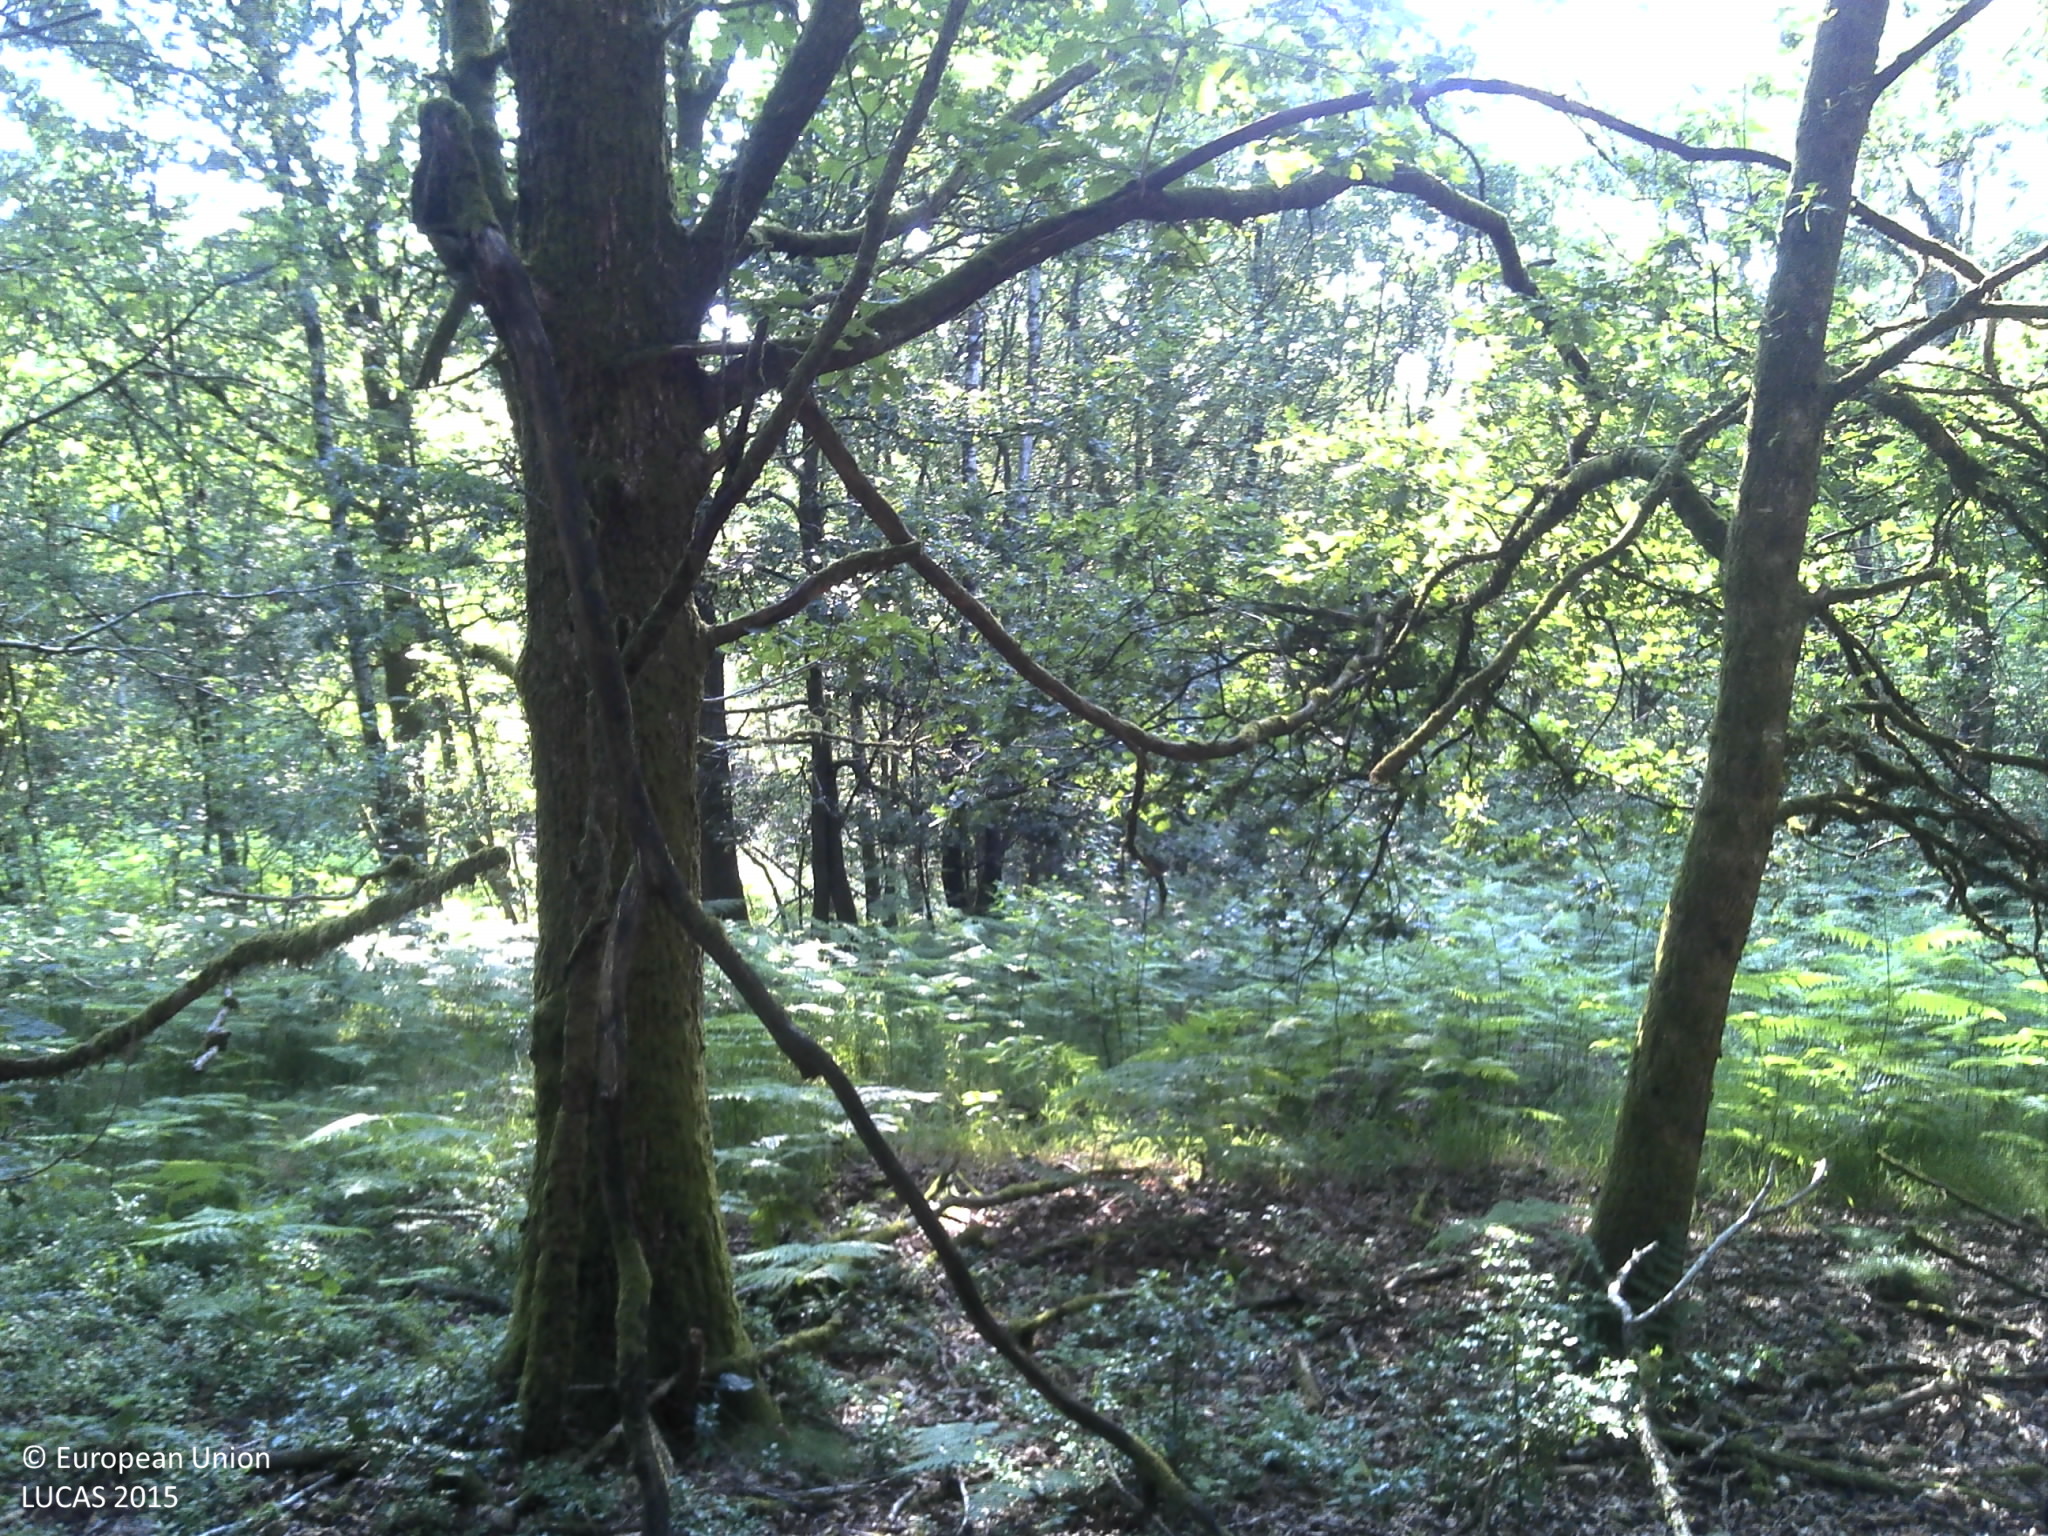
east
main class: Woodland
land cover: Broadleaved woodland
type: acidophilous oak and oak-birch forest
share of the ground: 50 - 75 %
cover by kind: broadleaved forest trees 70 %, herbaceous plants 15 %, consolidated bare surface 15 %
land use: Forestry
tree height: > 5 m
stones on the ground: < 10 %
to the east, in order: Broadleaved woodland; Ditches and canals; Broadleaved woodland; Ditches and canals; Broadleaved woodland; Ditches and canals; Broadleaved woodland
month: July
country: FR
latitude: 49.8560
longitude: 4.5576
